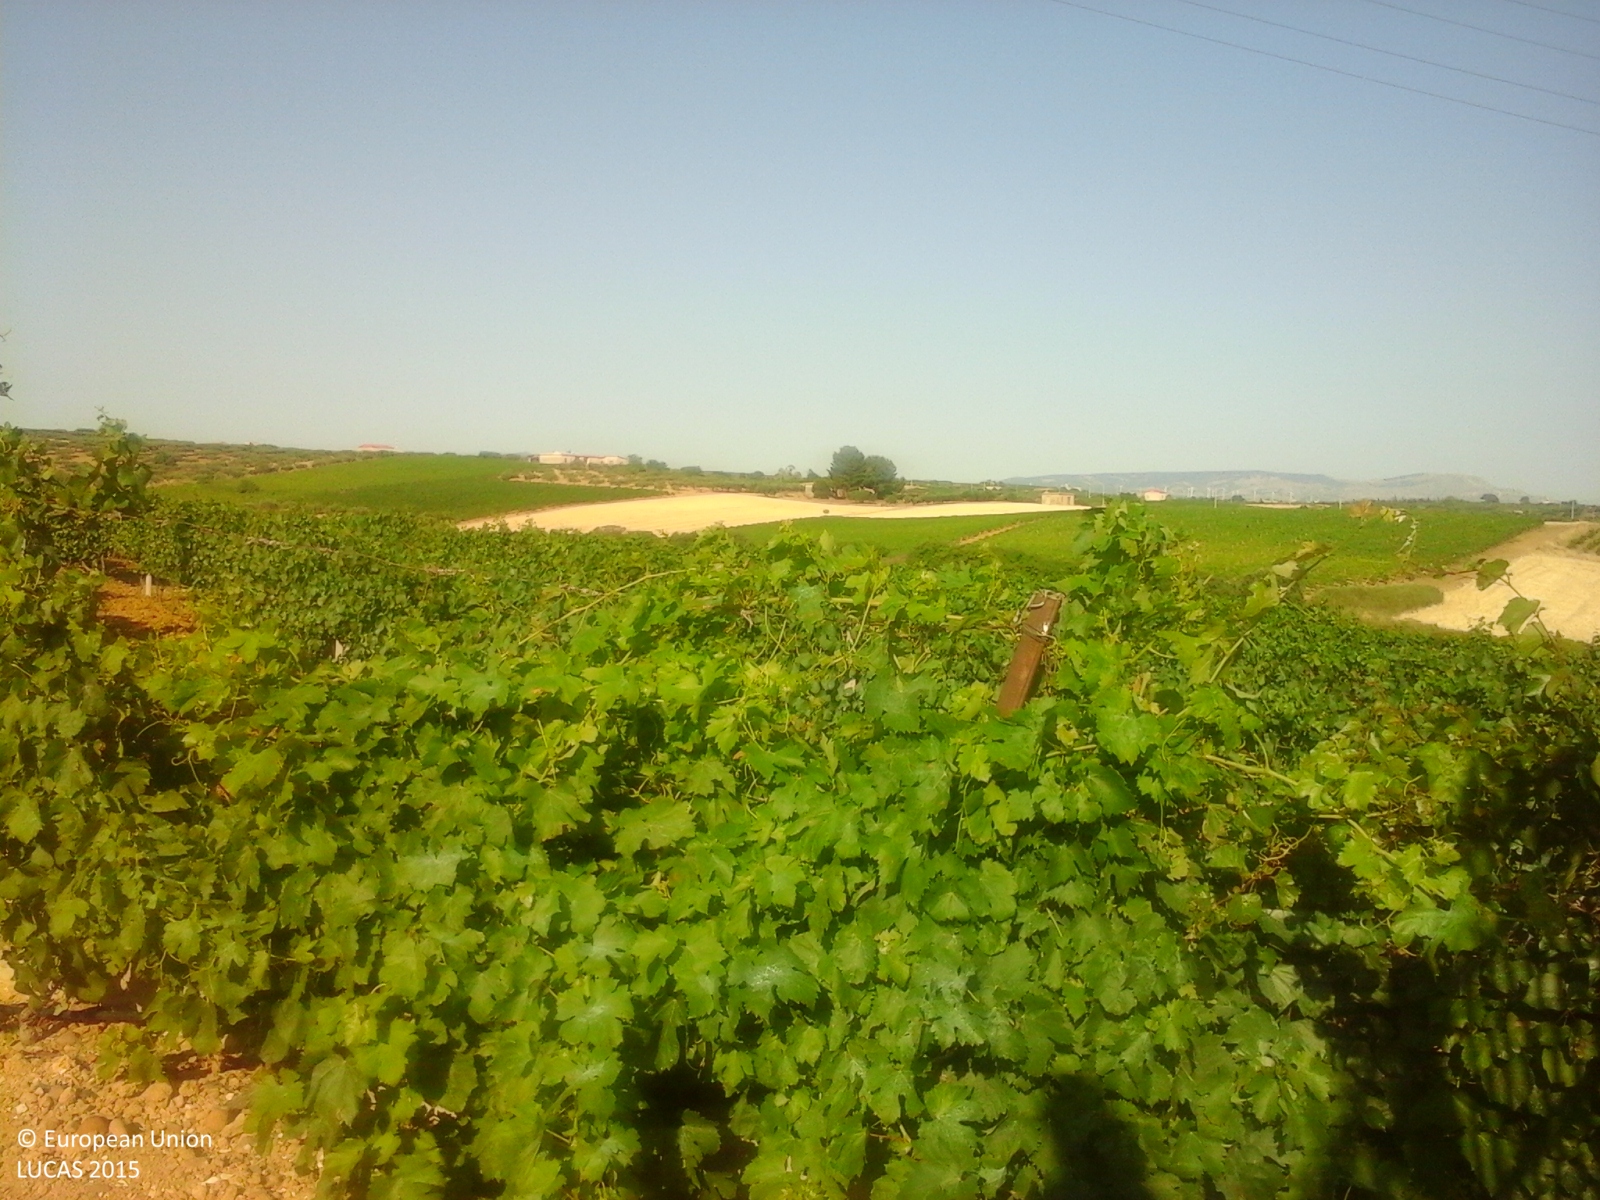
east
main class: Cropland
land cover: Vineyards
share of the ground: 25 - 50 %
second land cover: Other bare soil
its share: > 75 %
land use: Agriculture (excluding fallow land and kitchen gardens)
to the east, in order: Vineyards; Other bare soil; Olive groves; Vineyards; Rivers and streams; Vineyards; Rivers and streams
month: June
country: IT
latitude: 37.6484
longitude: 12.9134
